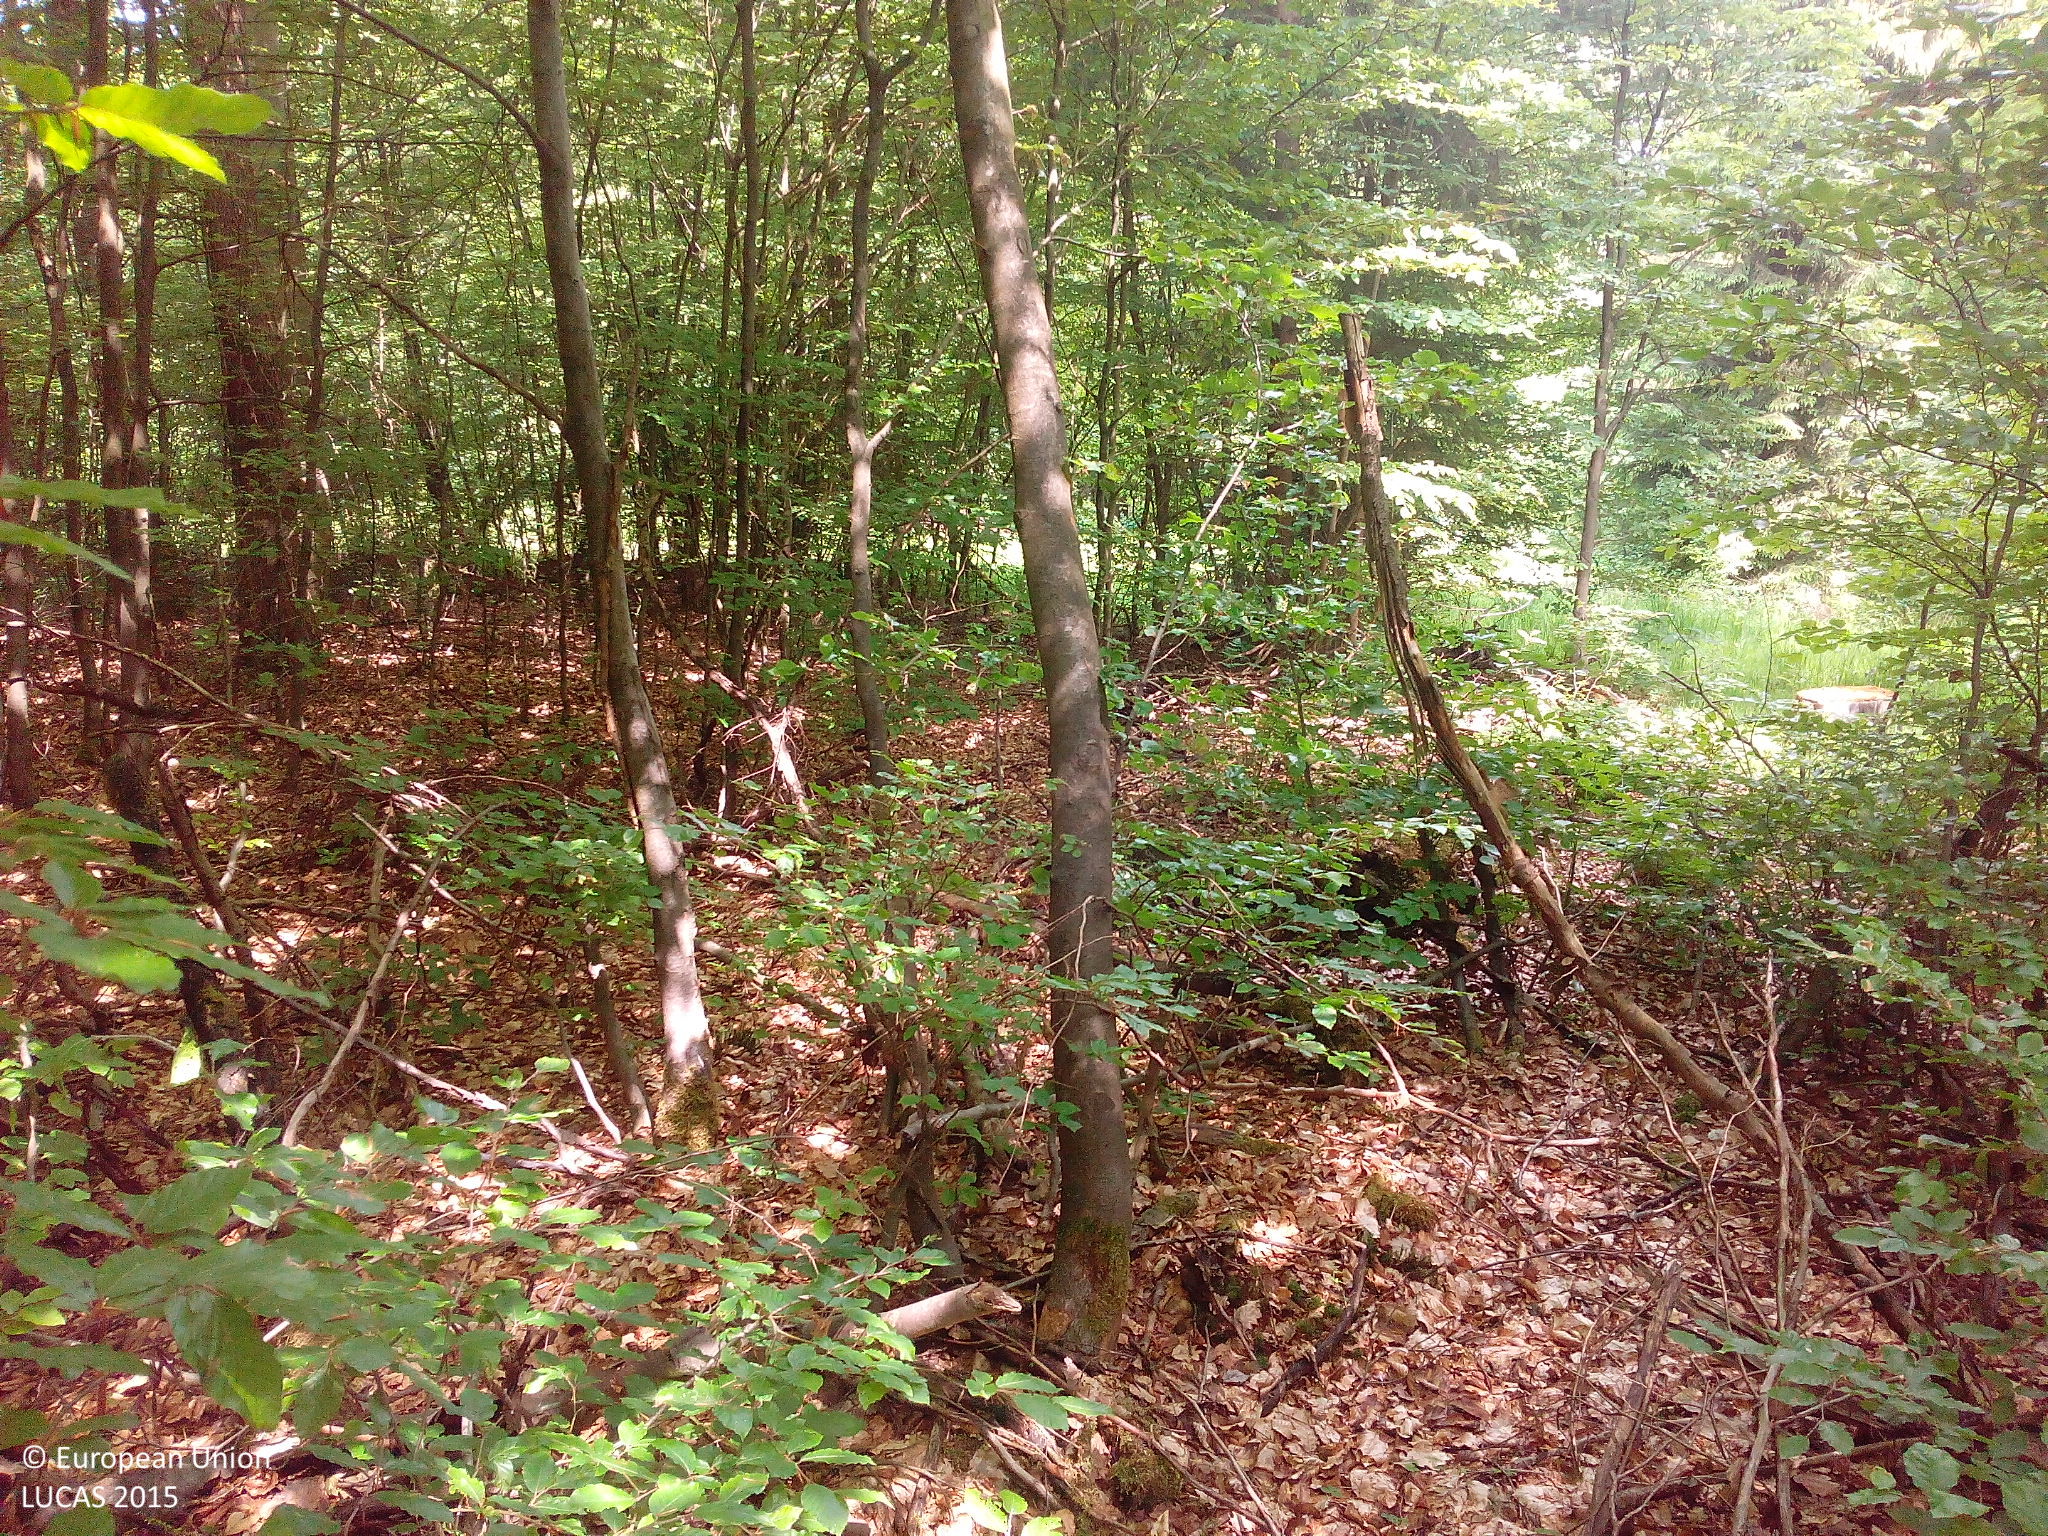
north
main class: Woodland
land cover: Broadleaved woodland
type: beech forest
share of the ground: > 75 %
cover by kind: broadleaved forest trees 95 %, unconsolidated bare surface 5 %
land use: Forestry
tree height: > 5 m
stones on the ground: < 10 %
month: May
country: DE
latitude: 51.2265
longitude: 9.6421
